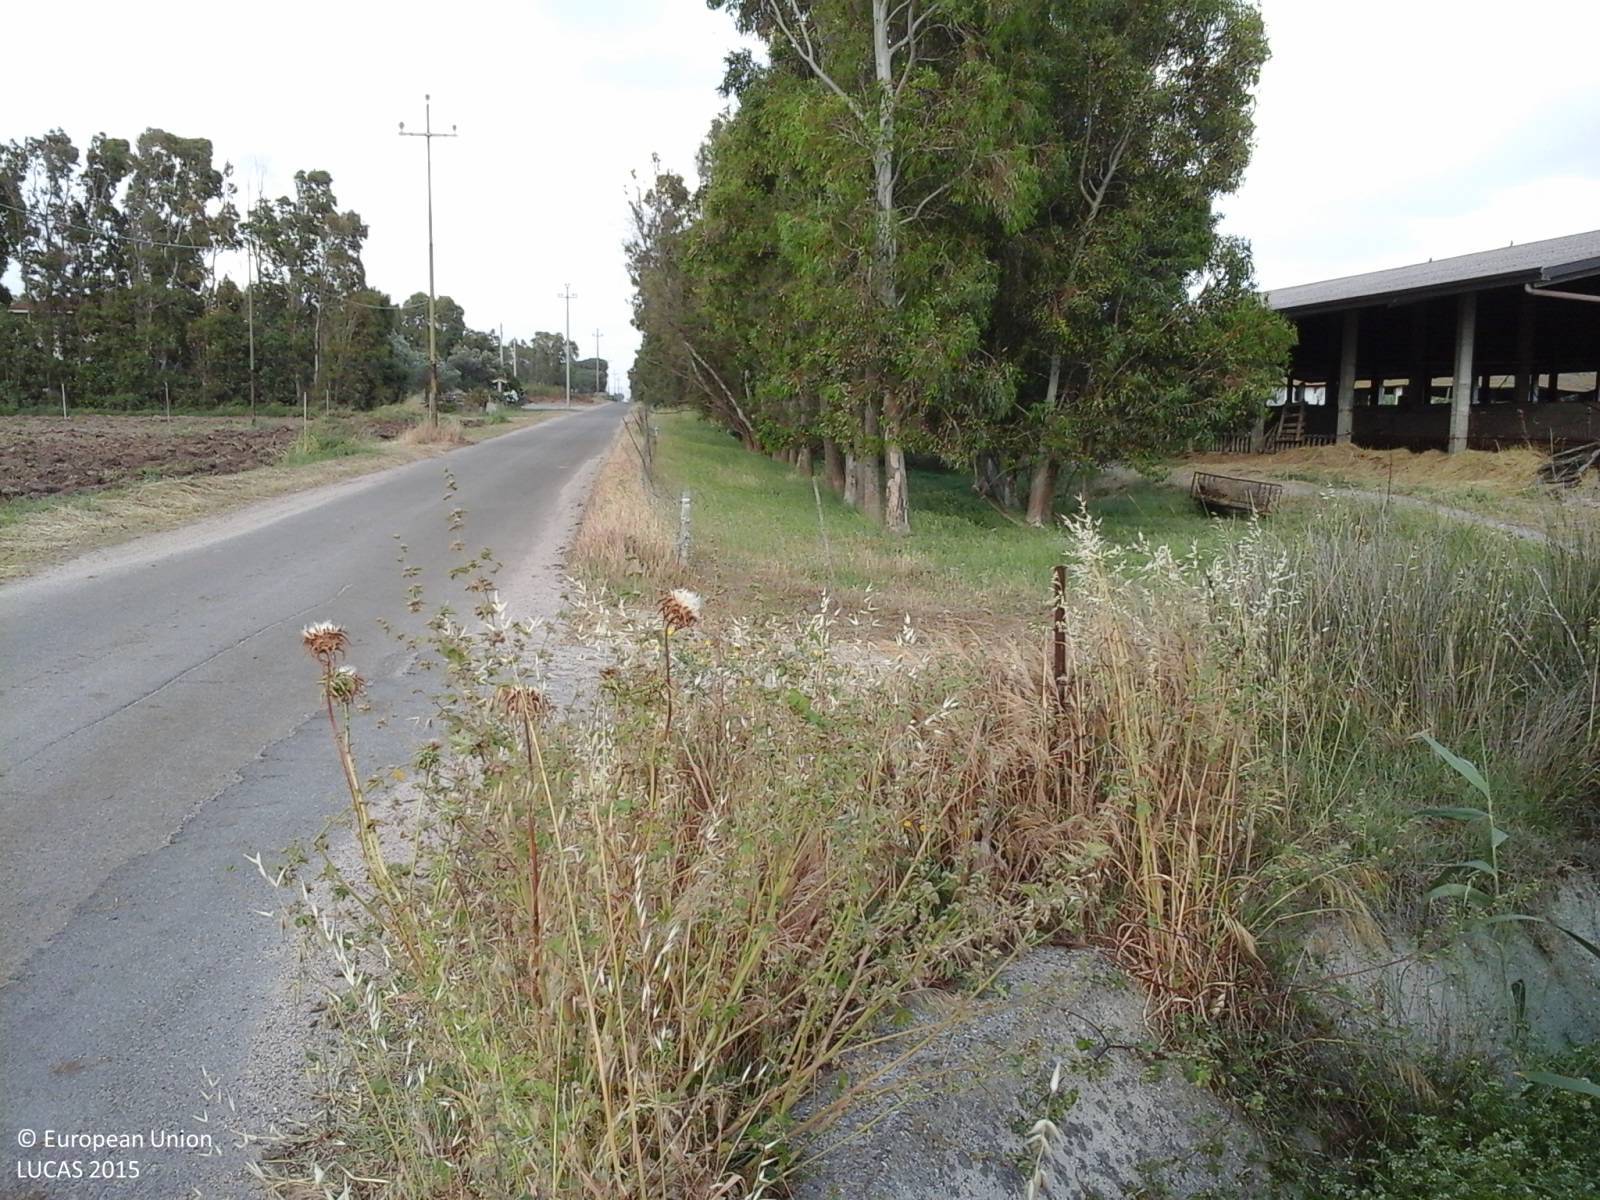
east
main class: Cropland
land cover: Clovers
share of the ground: > 75 %
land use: Agriculture (excluding fallow land and kitchen gardens)
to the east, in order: Clovers; Broadleaved woodland; Maize; Broadleaved woodland; Tracks; Broadleaved woodland; Maize; Broadleaved woodland
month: May
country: IT
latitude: 39.7133
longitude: 8.5502
